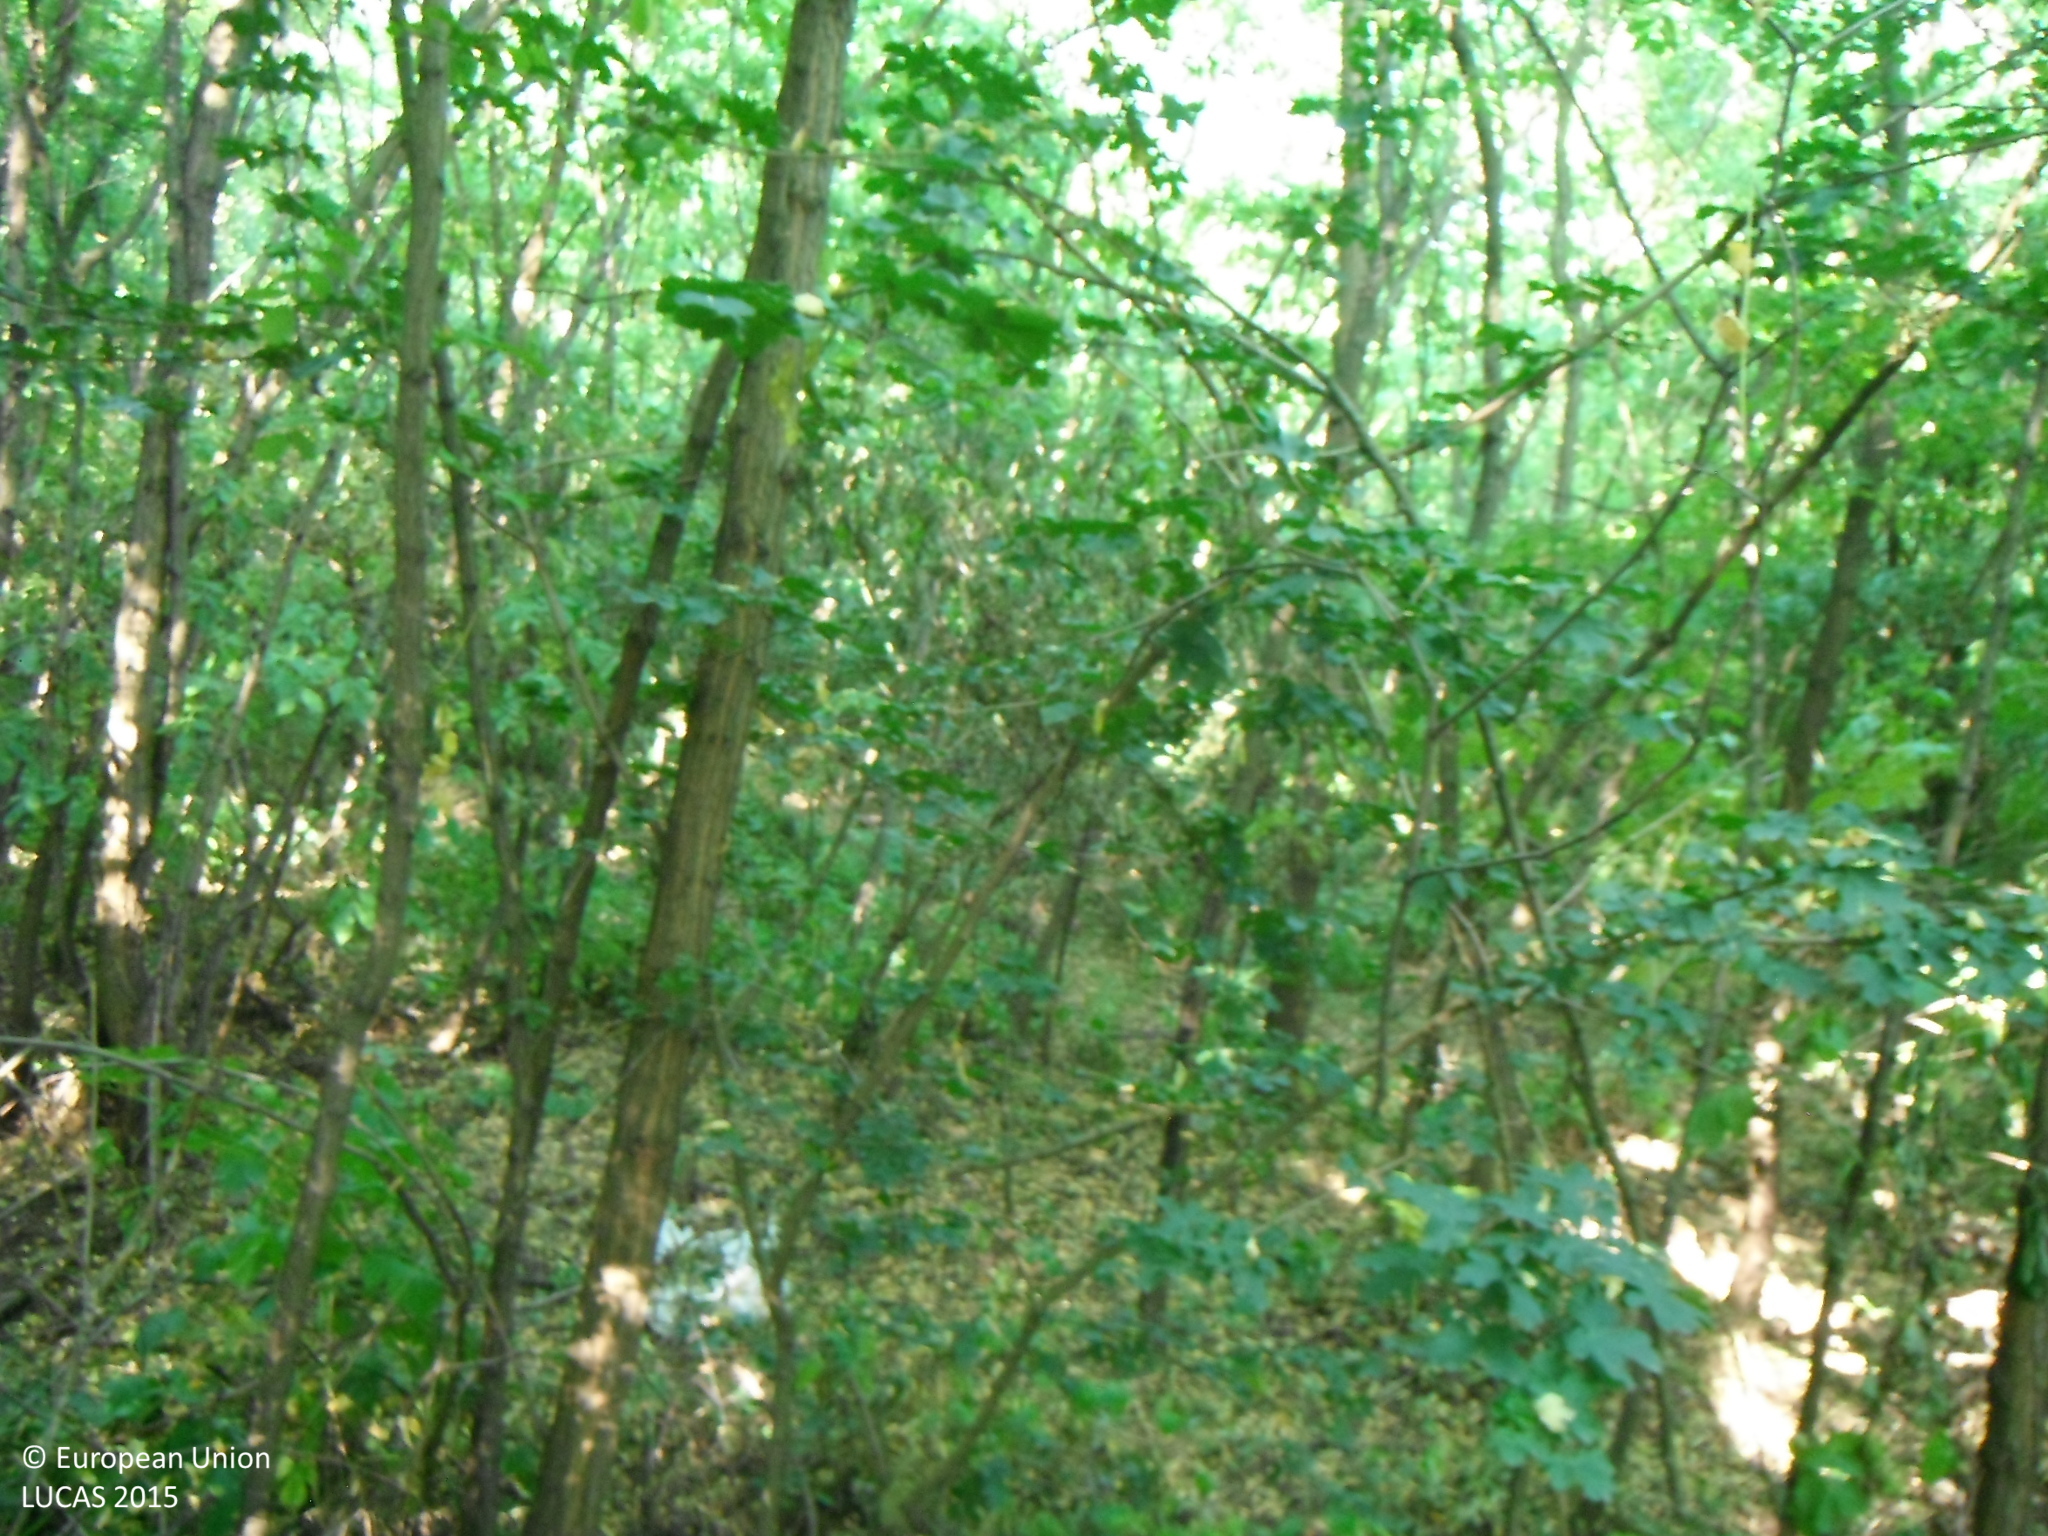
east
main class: Woodland
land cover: Broadleaved woodland
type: exotic forest
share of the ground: > 75 %
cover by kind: broadleaved forest trees 90 %, shrubs 10 %
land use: Forestry
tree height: > 5 m
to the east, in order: Broadleaved woodland; Rape and turnip rape; Broadleaved woodland
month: July
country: SK
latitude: 48.1392
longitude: 19.2811
